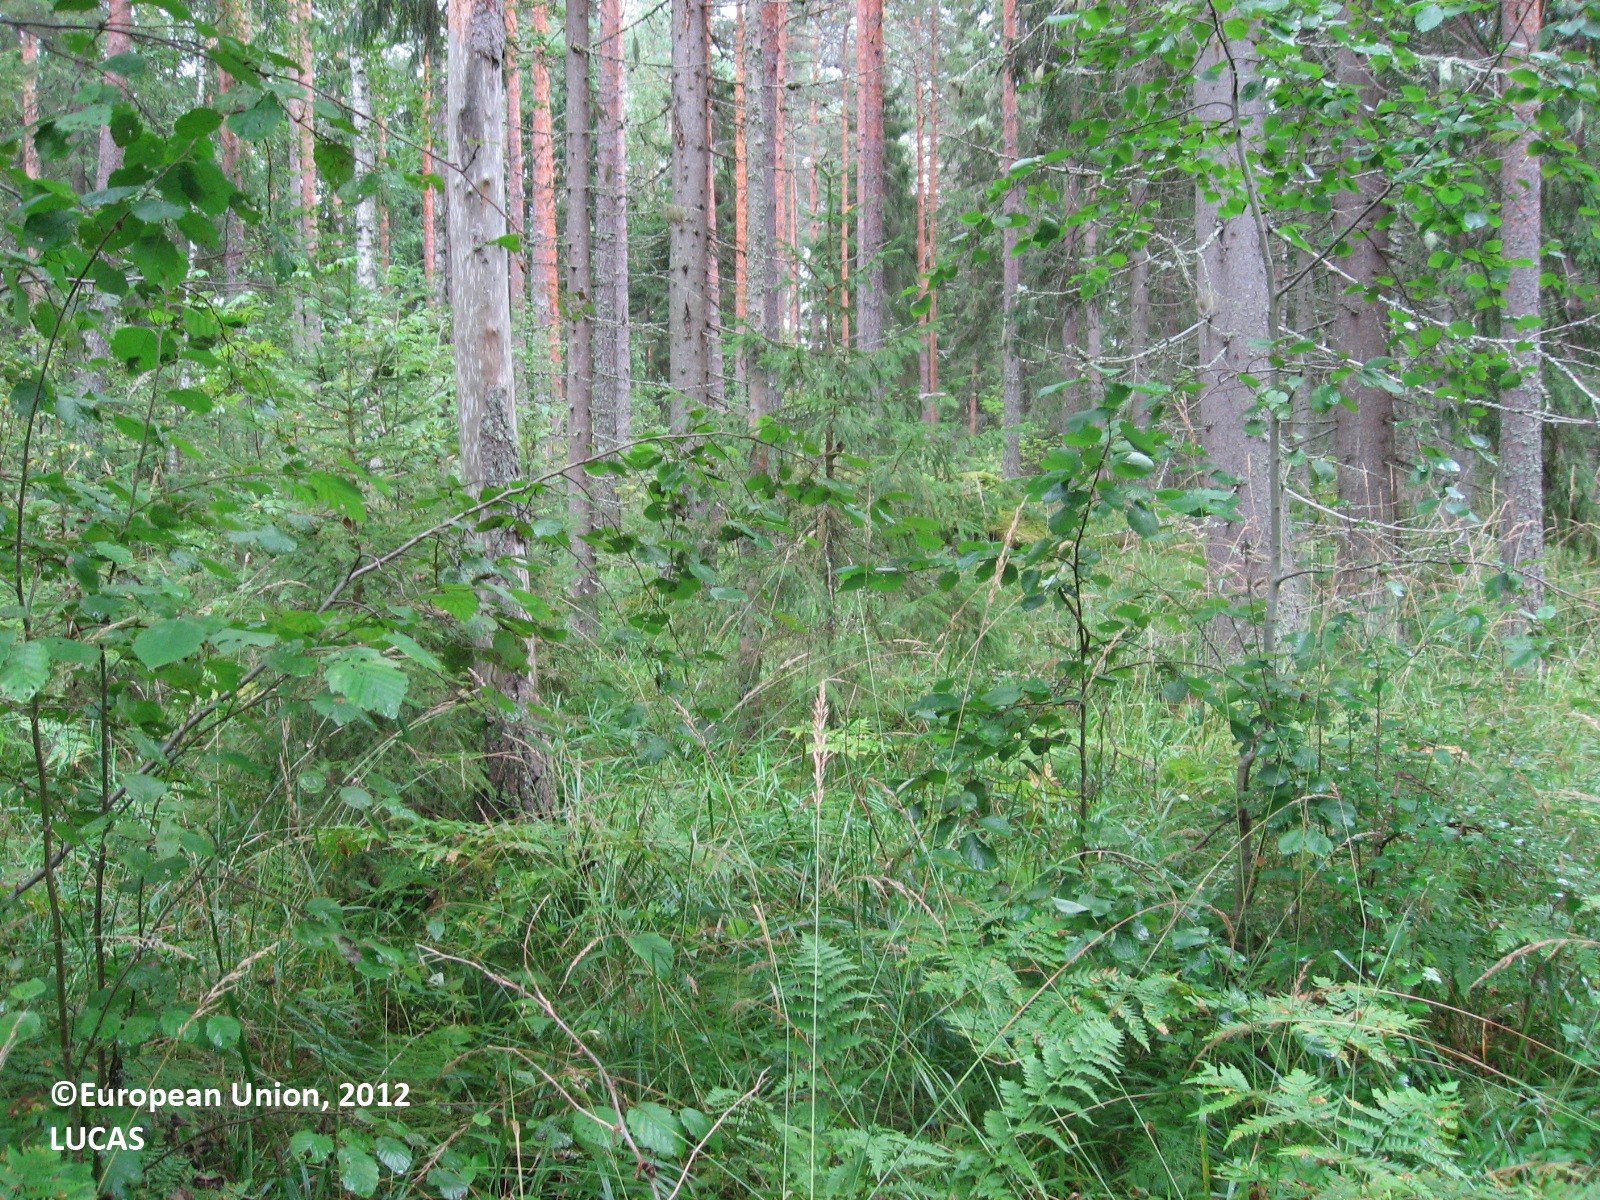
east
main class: Woodland
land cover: Spruce dominated mixed woodland
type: boreal forest
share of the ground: 50 - 75 %
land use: Forestry
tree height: > 5 m
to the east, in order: Spruce dominated mixed woodland; Pine dominated mixed woodland; Spruce dominated mixed woodland; Inland marshes; Inland water bodies; Inland marshes; Pine dominated mixed woodland
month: August
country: FI
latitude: 61.3686
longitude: 24.7151
